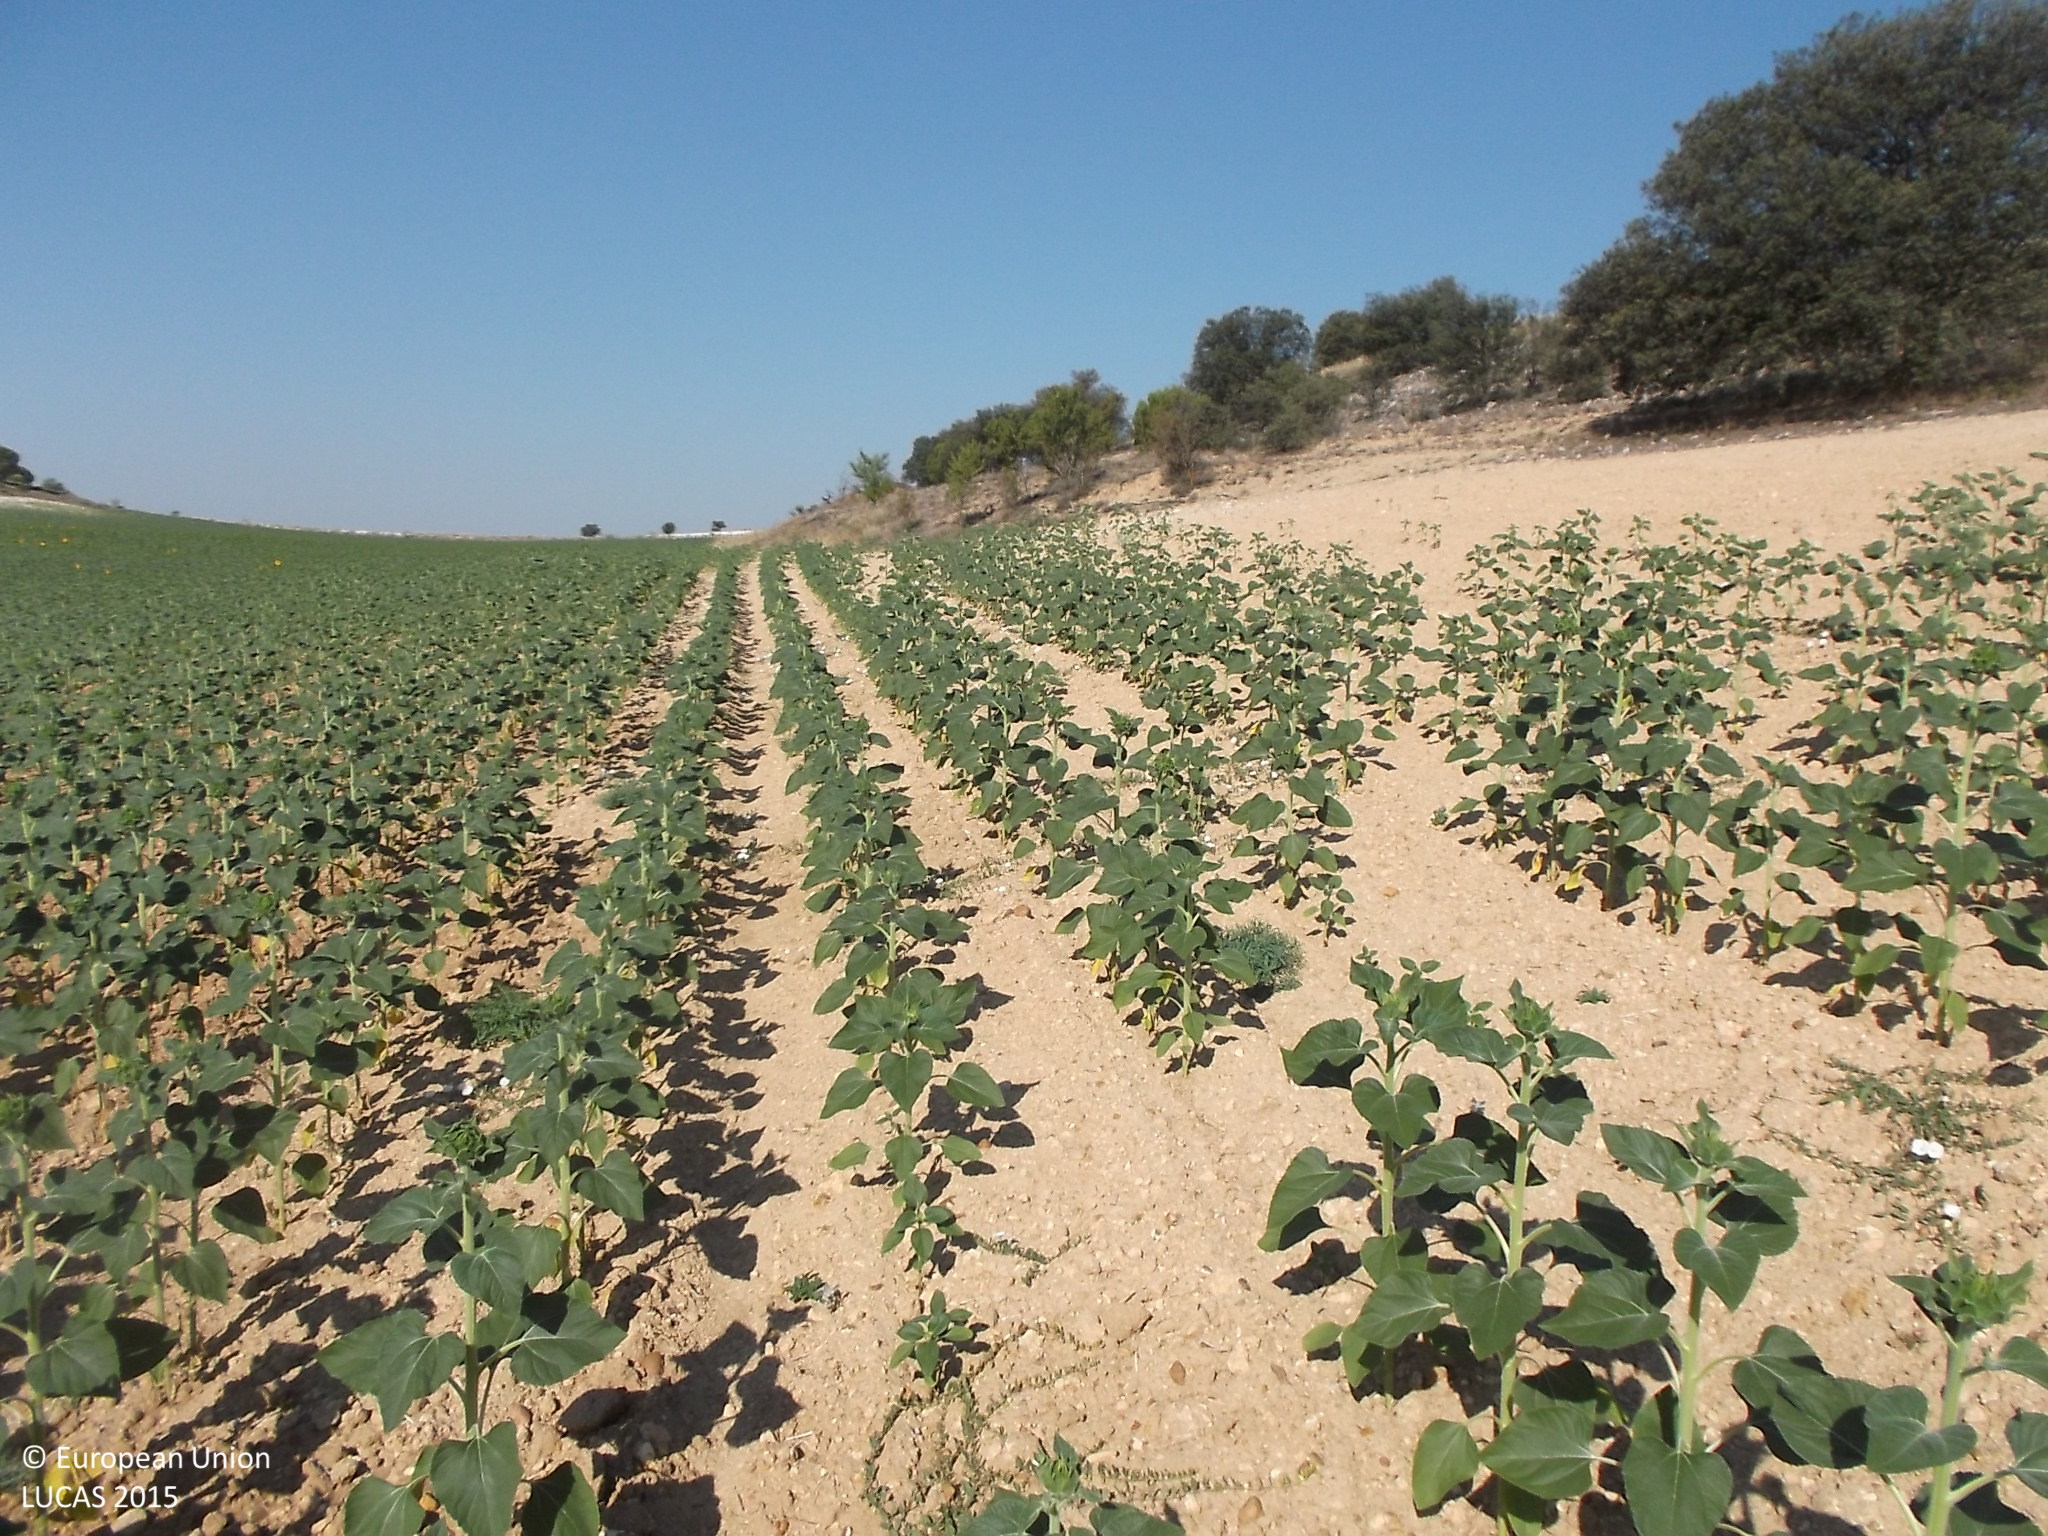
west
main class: Cropland
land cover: Sunflower
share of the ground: > 75 %
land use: Agriculture (excluding fallow land and kitchen gardens)
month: July
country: ES
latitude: 41.4125
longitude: -5.4035
